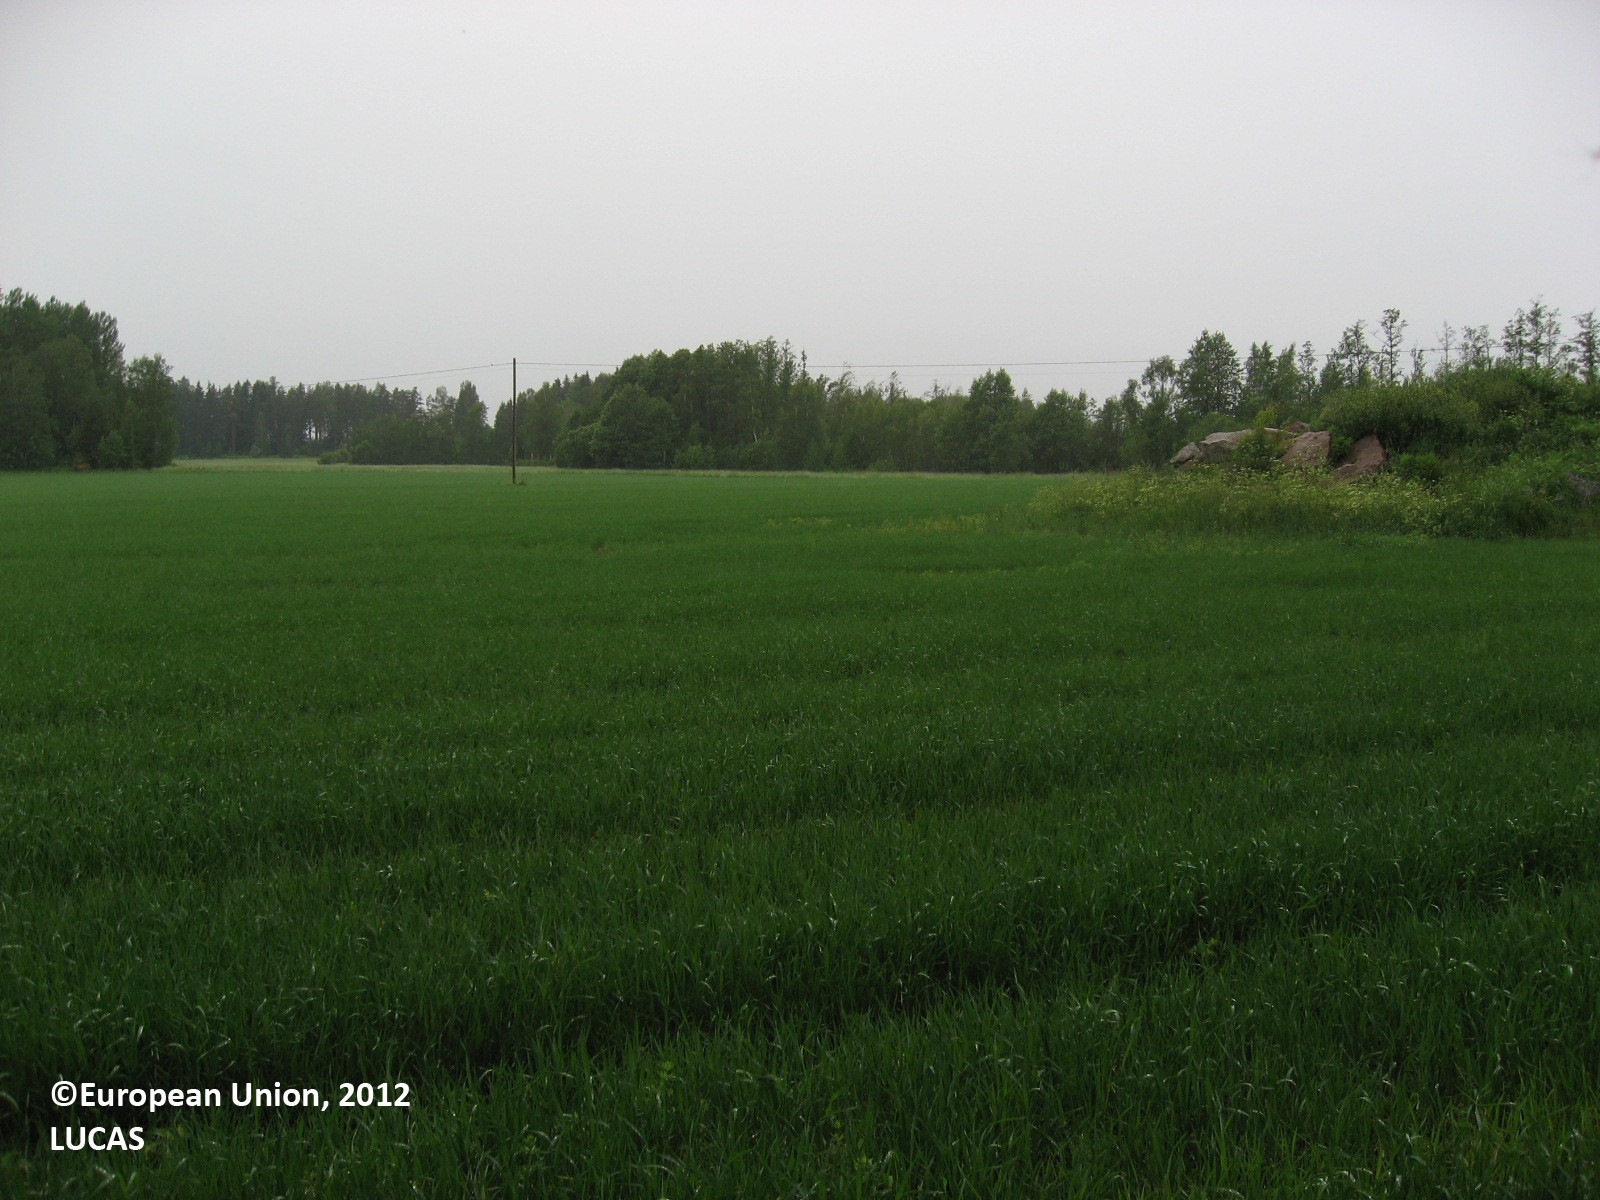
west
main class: Cropland
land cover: Common wheat
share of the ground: > 75 %
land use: Agriculture (excluding fallow land and kitchen gardens)
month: June
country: FI
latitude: 60.5337
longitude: 26.1282
